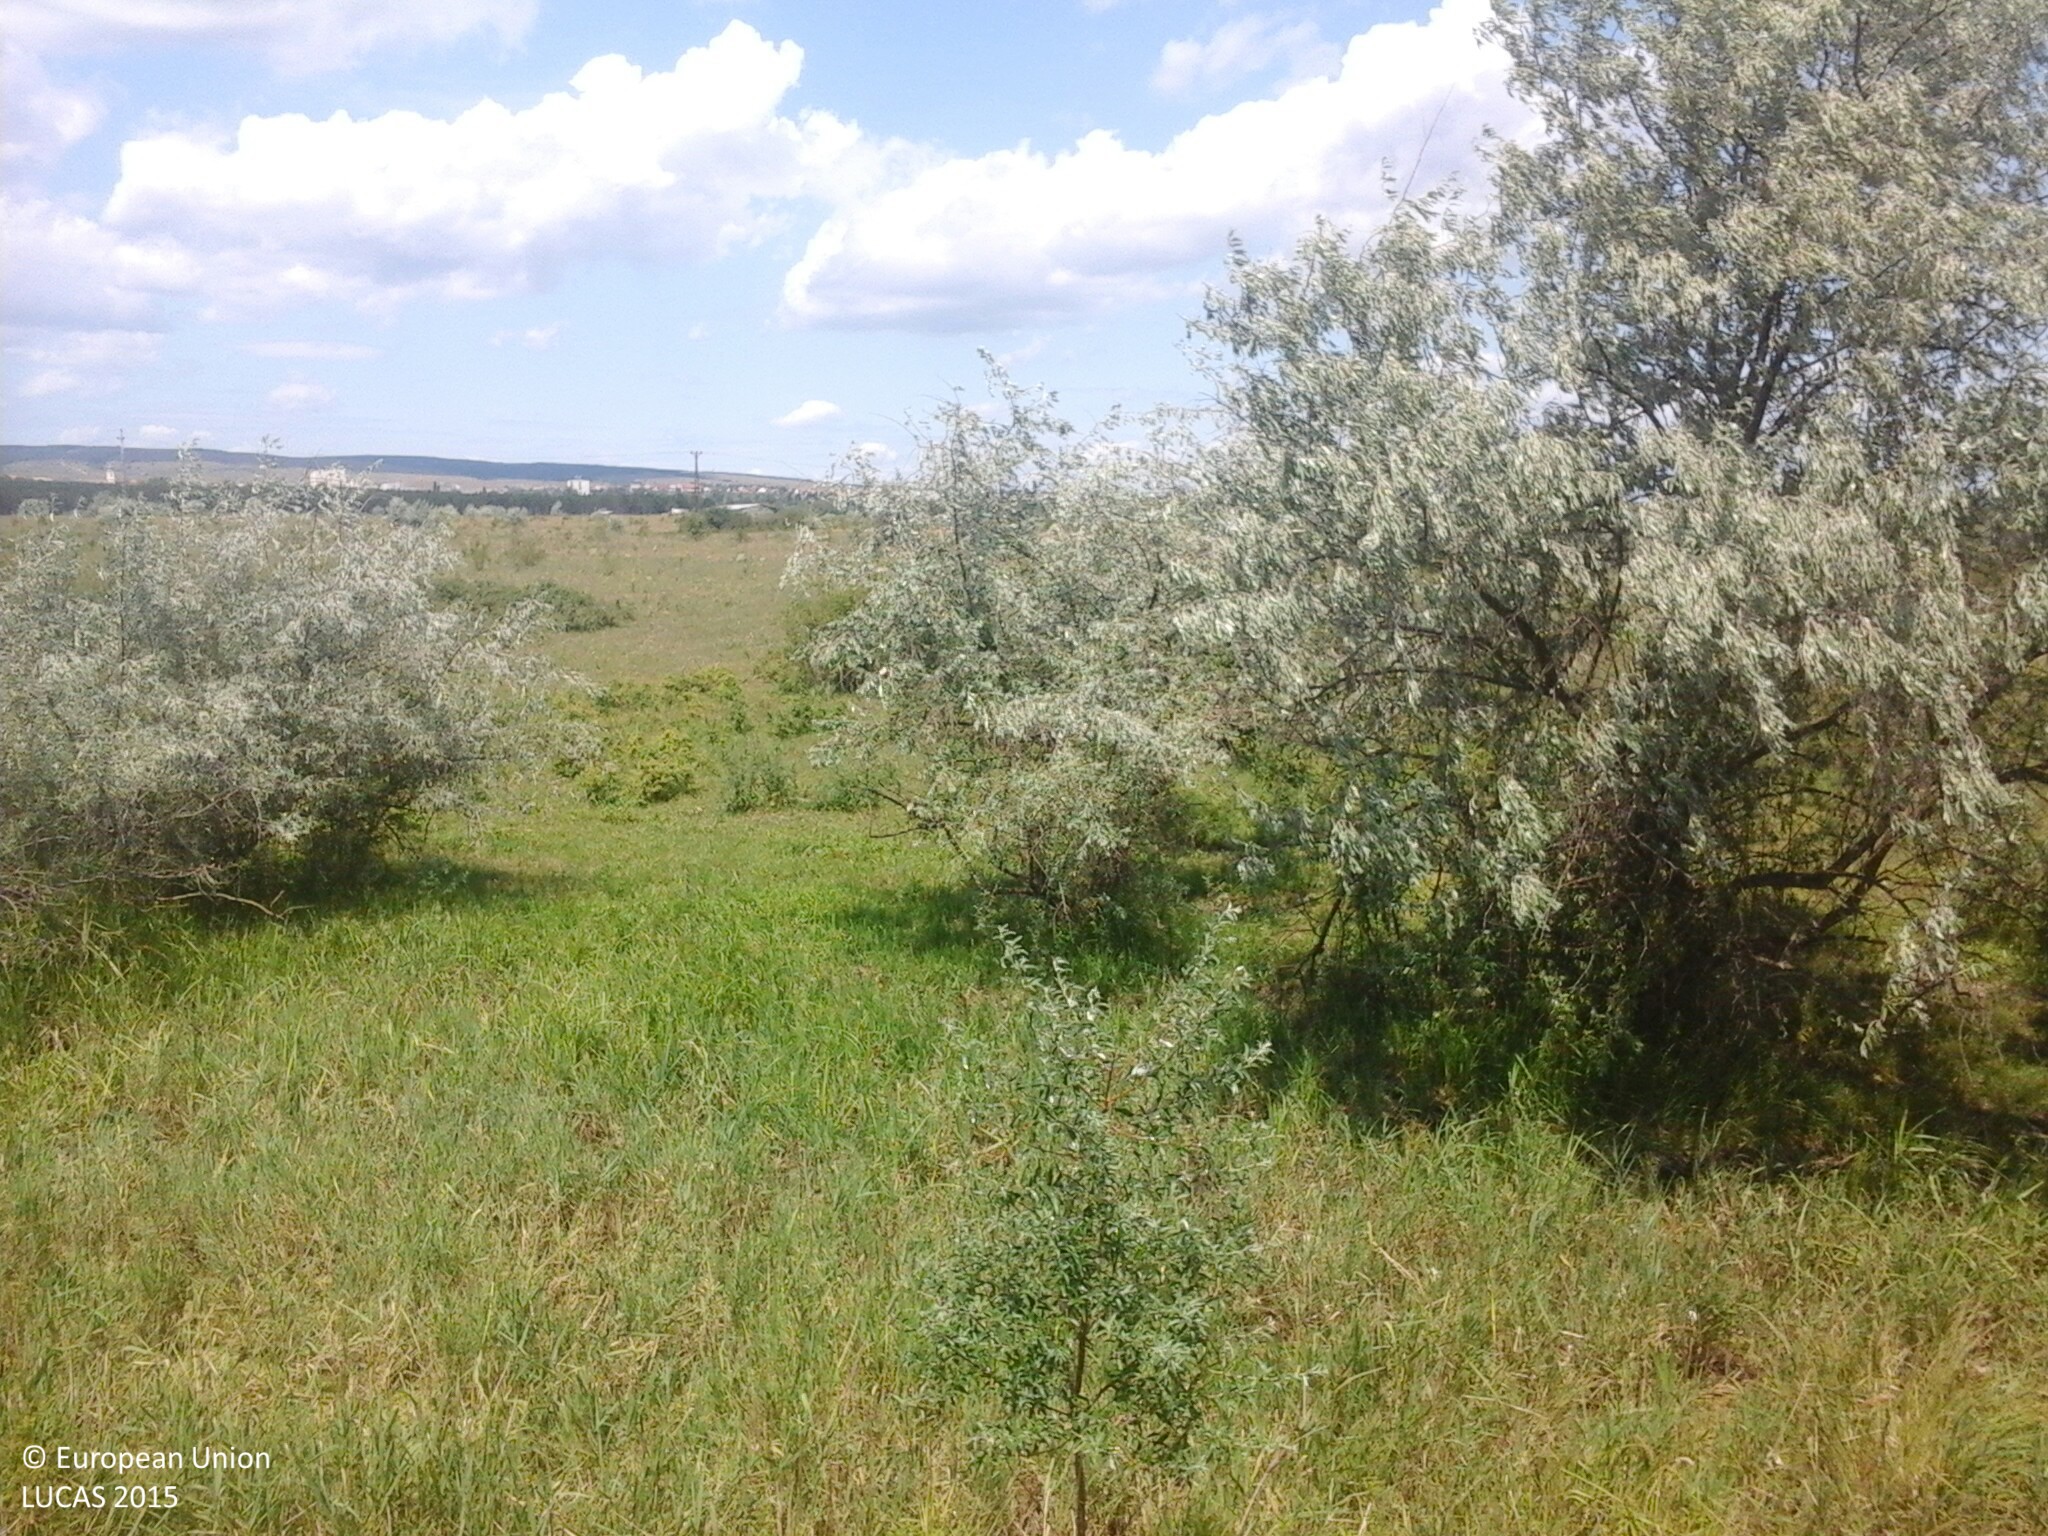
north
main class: Grassland
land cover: Grassland with sparse tree/shrub cover
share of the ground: > 75 %
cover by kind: herbaceous plants 90 %, broadleaved forest trees 5 %, shrubs 5 %
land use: Agriculture (excluding fallow land and kitchen gardens)
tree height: > 5 m
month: July
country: HU
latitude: 47.1797
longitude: 18.1521
